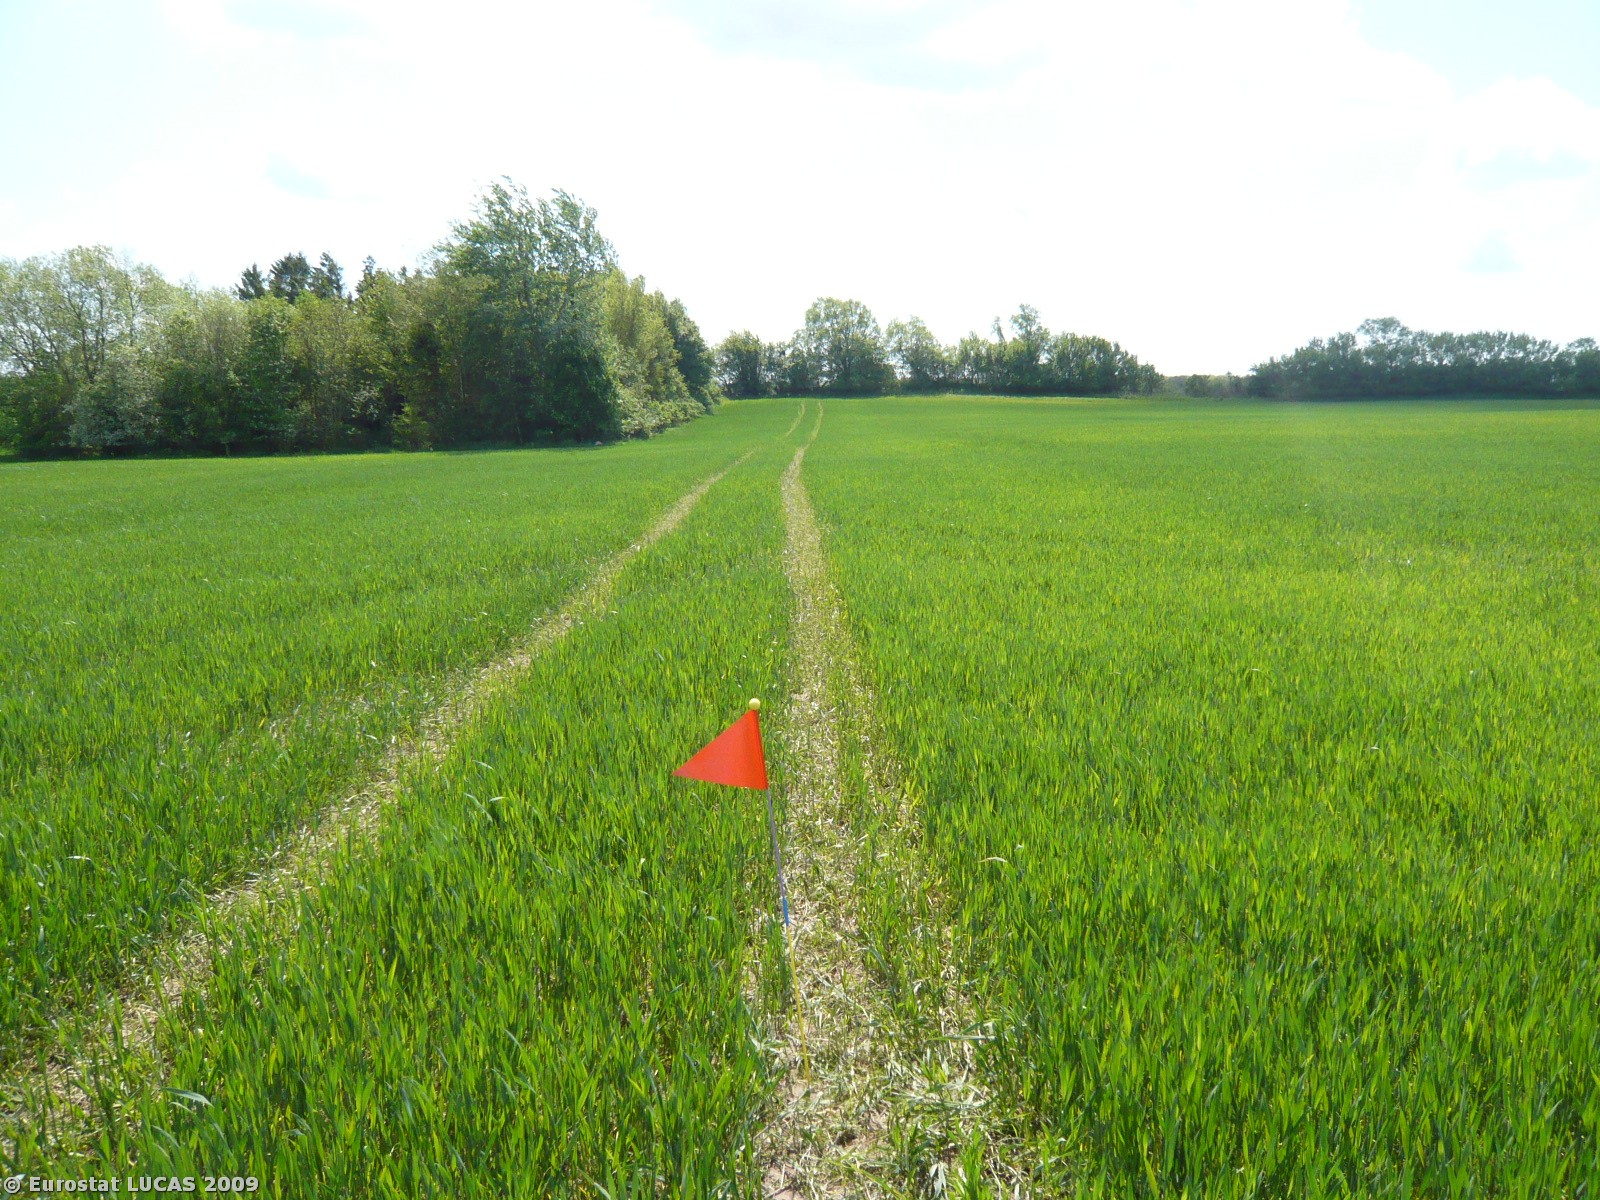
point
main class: Cropland
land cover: Common wheat
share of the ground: > 75 %
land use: Agriculture (excluding fallow land and kitchen gardens)
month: May
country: DK
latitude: 55.3979
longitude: 12.0669
